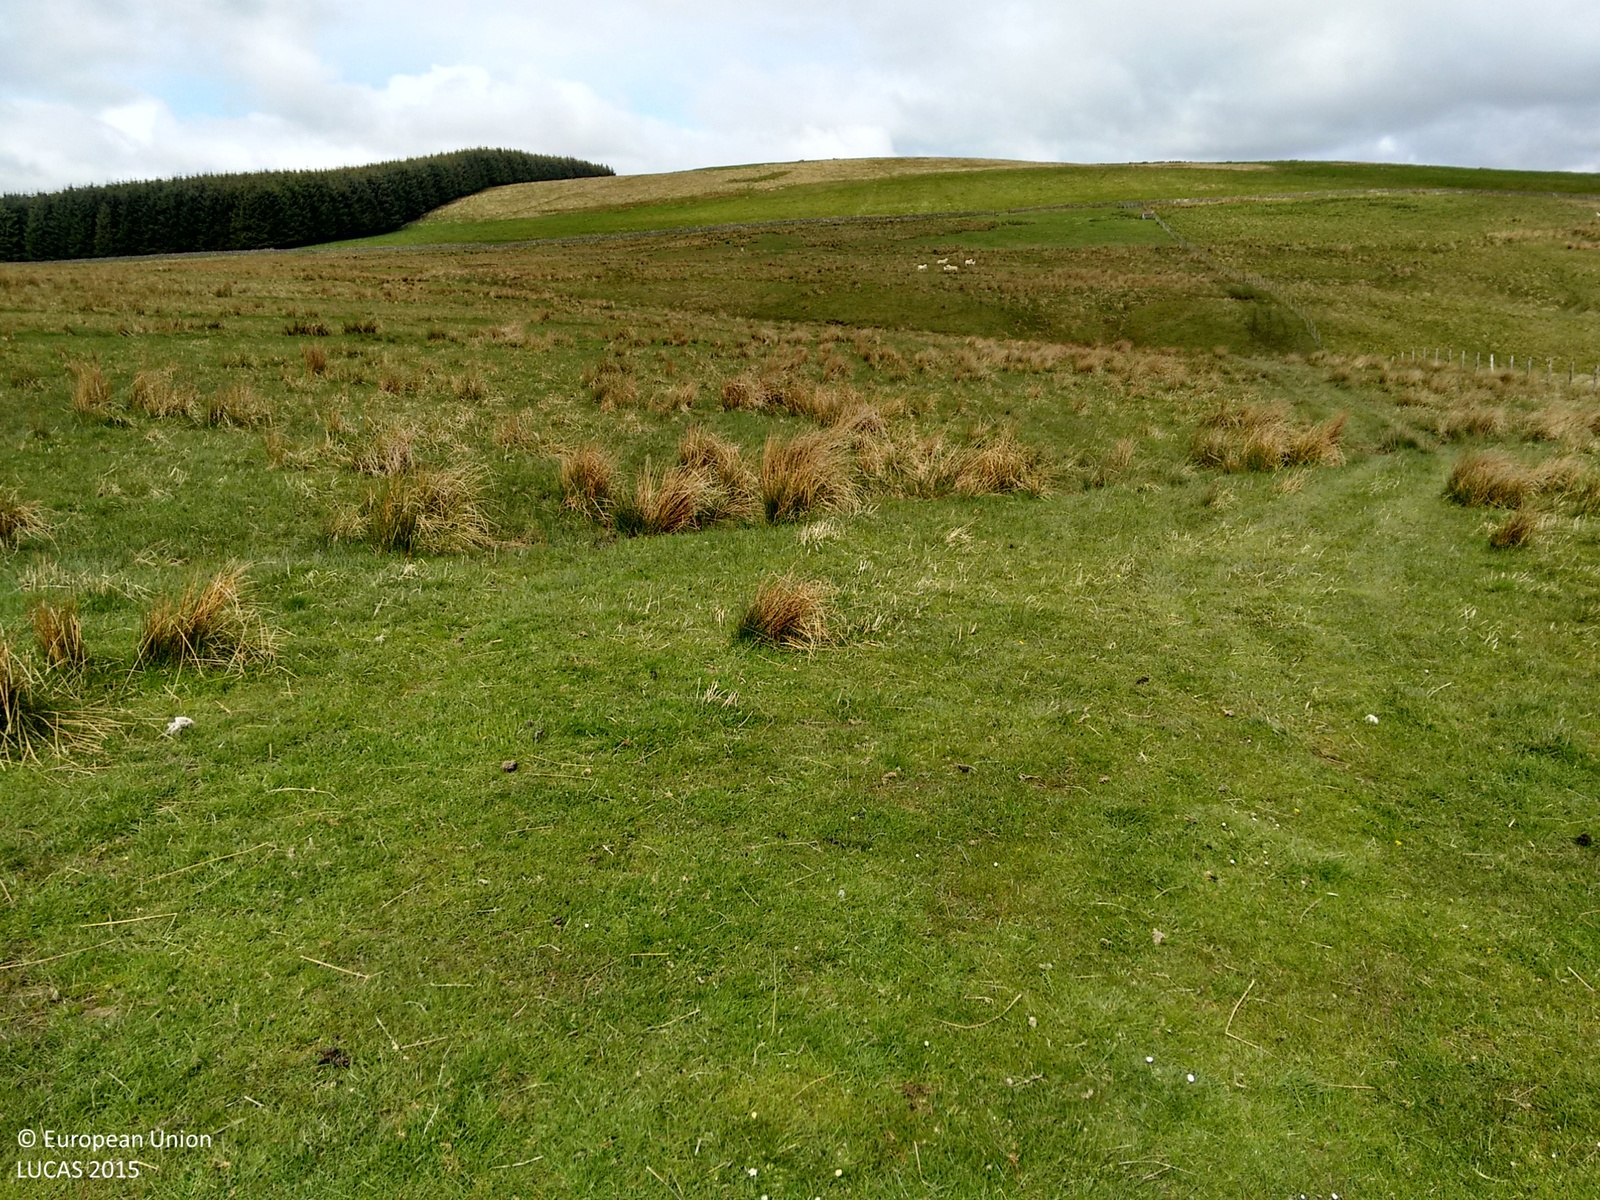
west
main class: Grassland
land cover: Grassland without tree/shrub cover
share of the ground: > 75 %
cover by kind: herbaceous plants 100 %
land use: Agriculture (excluding fallow land and kitchen gardens)
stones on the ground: < 10 %
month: May
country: GB
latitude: 55.3843
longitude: -2.3872
